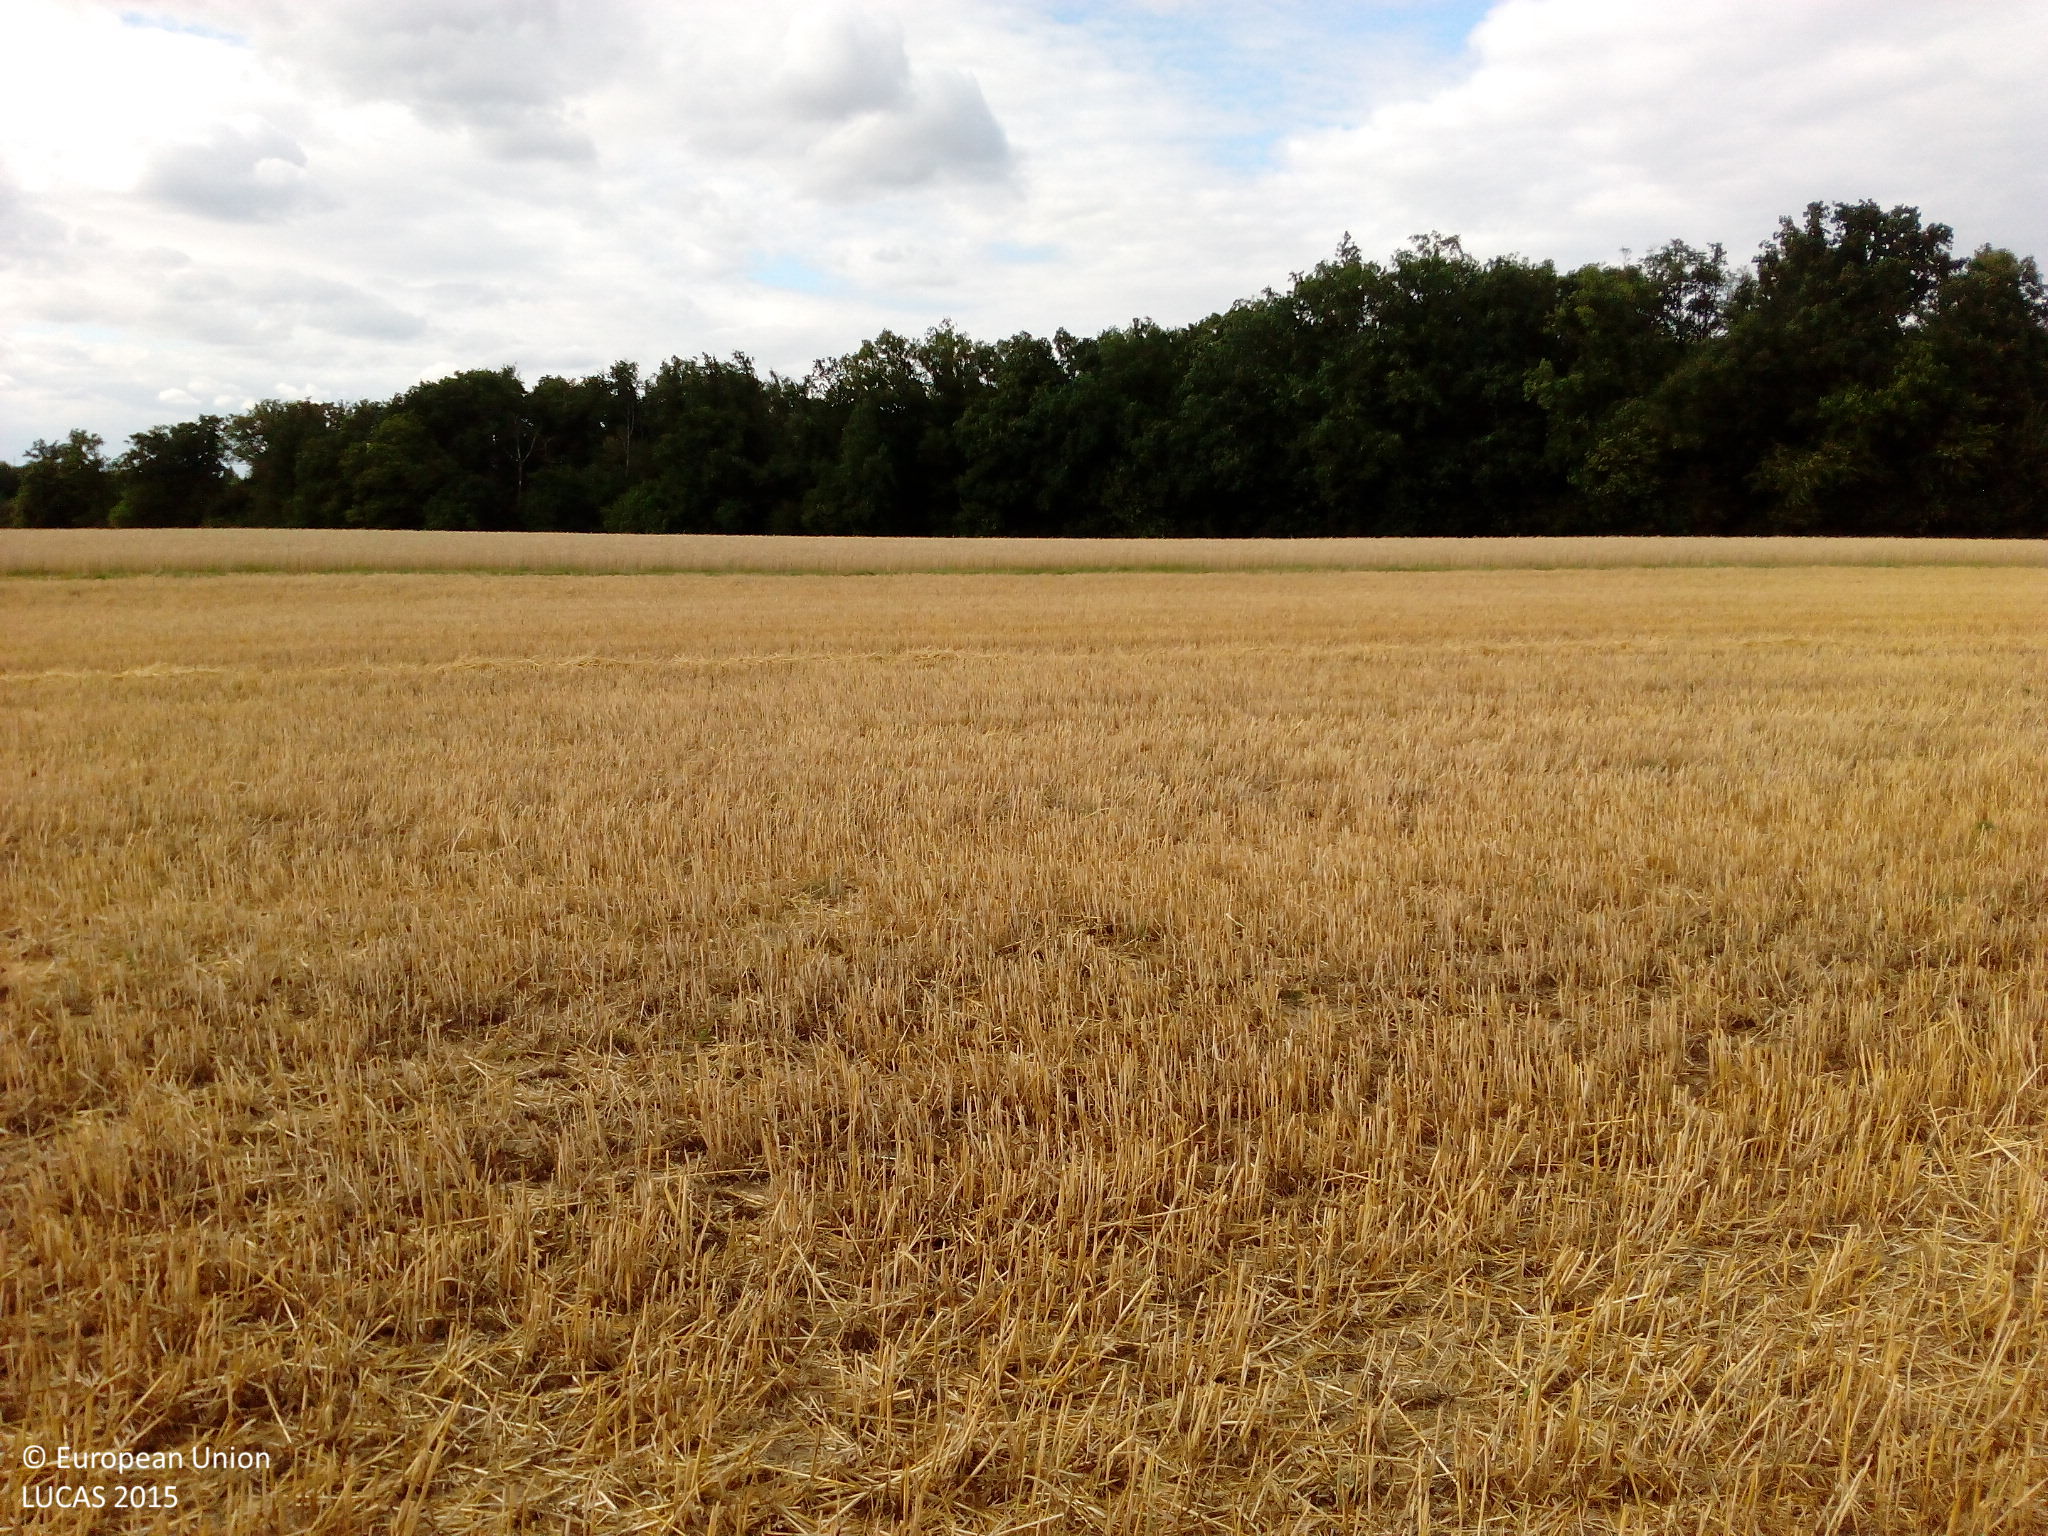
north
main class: Cropland
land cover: Barley
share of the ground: 50 - 75 %
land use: Agriculture (excluding fallow land and kitchen gardens)
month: July
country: DE
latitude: 49.7346
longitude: 9.9307
